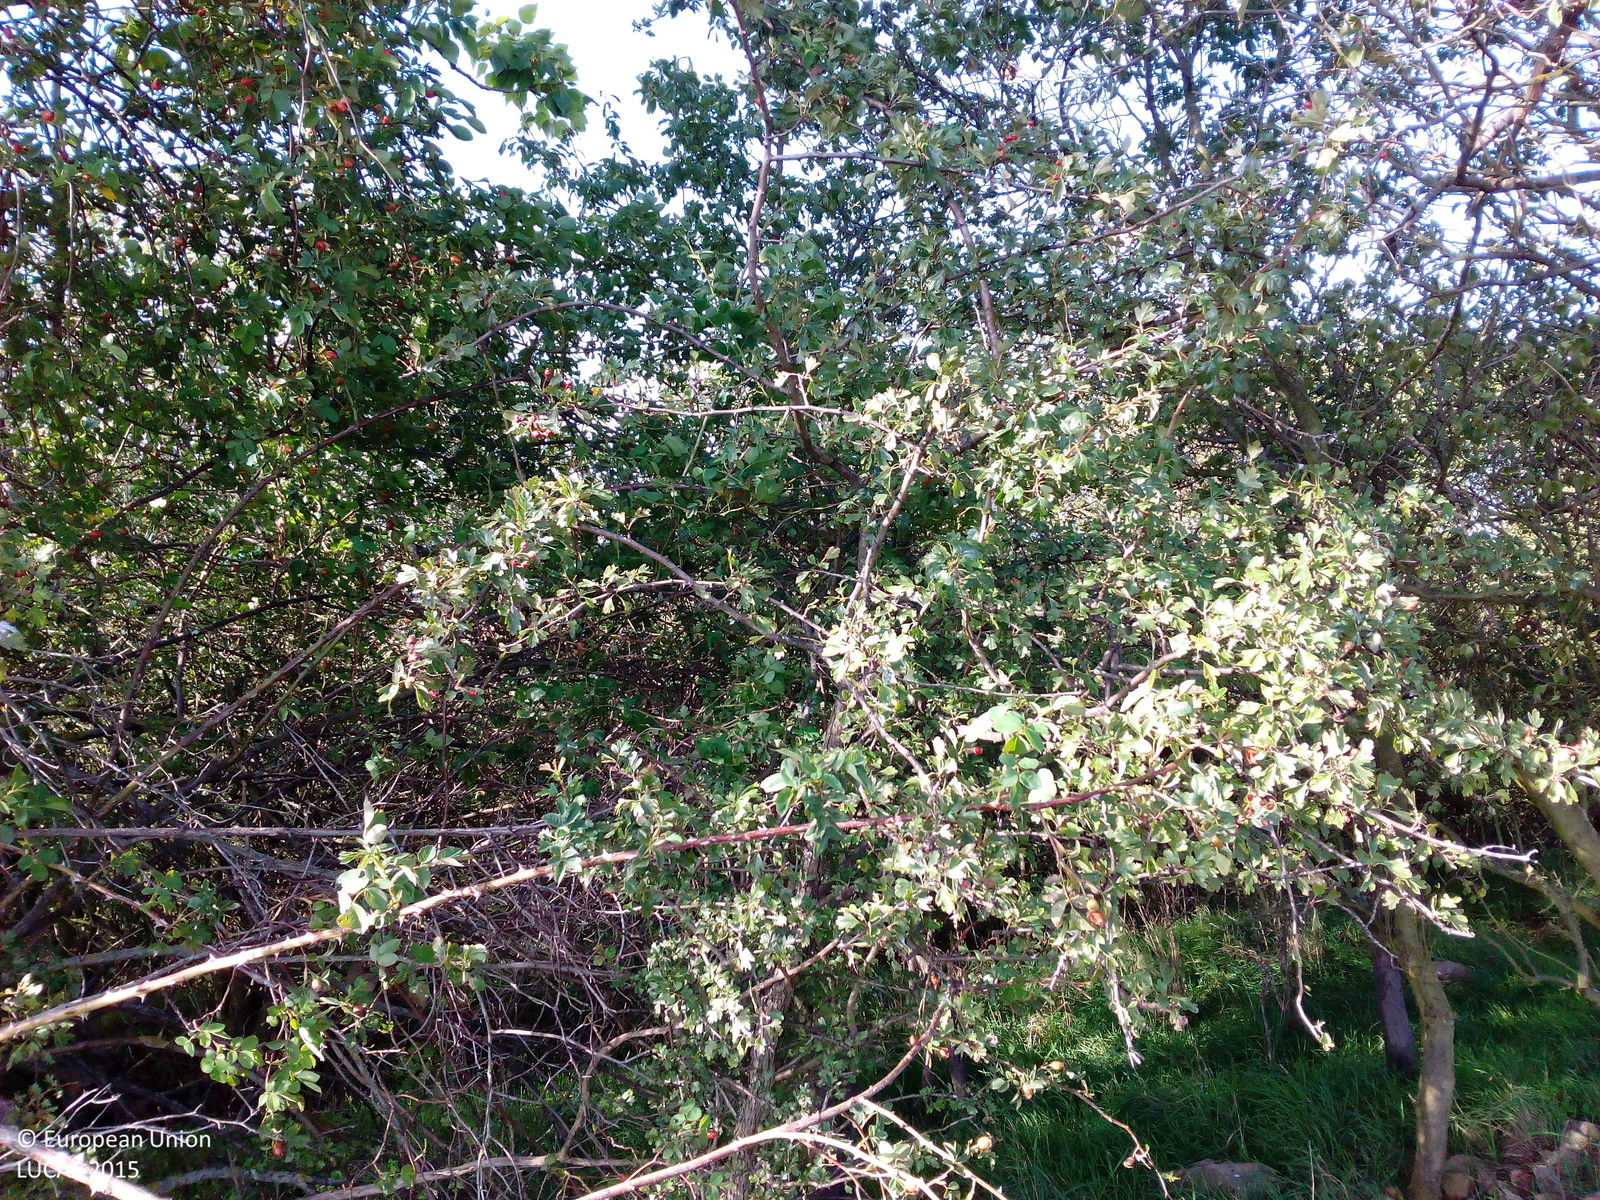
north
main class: Woodland
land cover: Broadleaved woodland
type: hemiboreal forest and nemoral coniferous forest and mixed broadleaved-coniferous forest
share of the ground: > 75 %
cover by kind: broadleaved forest trees 80 %, shrubs 10 %, herbaceous plants 10 %
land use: Forestry
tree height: > 5 m
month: September
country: DE
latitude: 51.7610
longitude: 11.1153
